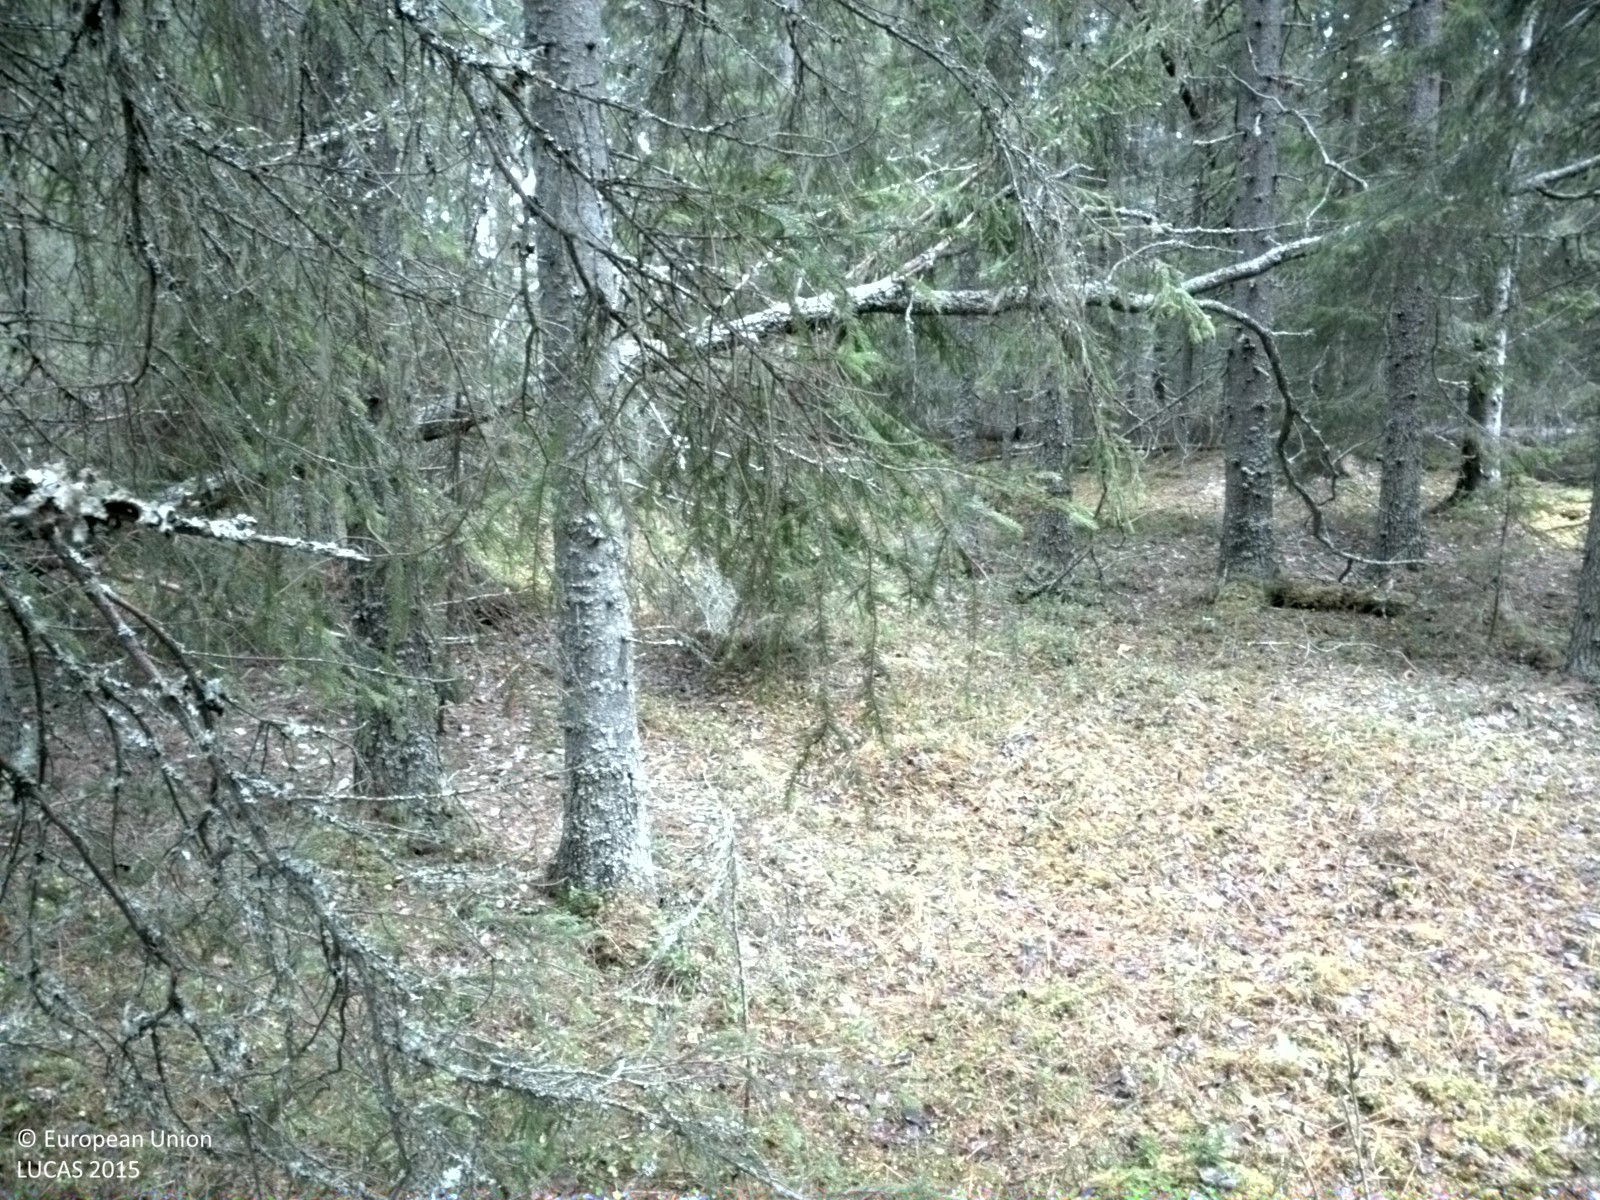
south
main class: Woodland
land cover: Spruce dominated coniferous woodland
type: boreal forest
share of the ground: > 75 %
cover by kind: coniferous forest trees 90 %, shrubs 5 %, lichens and mosses 5 %
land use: Forestry
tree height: > 5 m
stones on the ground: 10 - 25 %
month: May
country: SE
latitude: 63.4308
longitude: 13.8081
